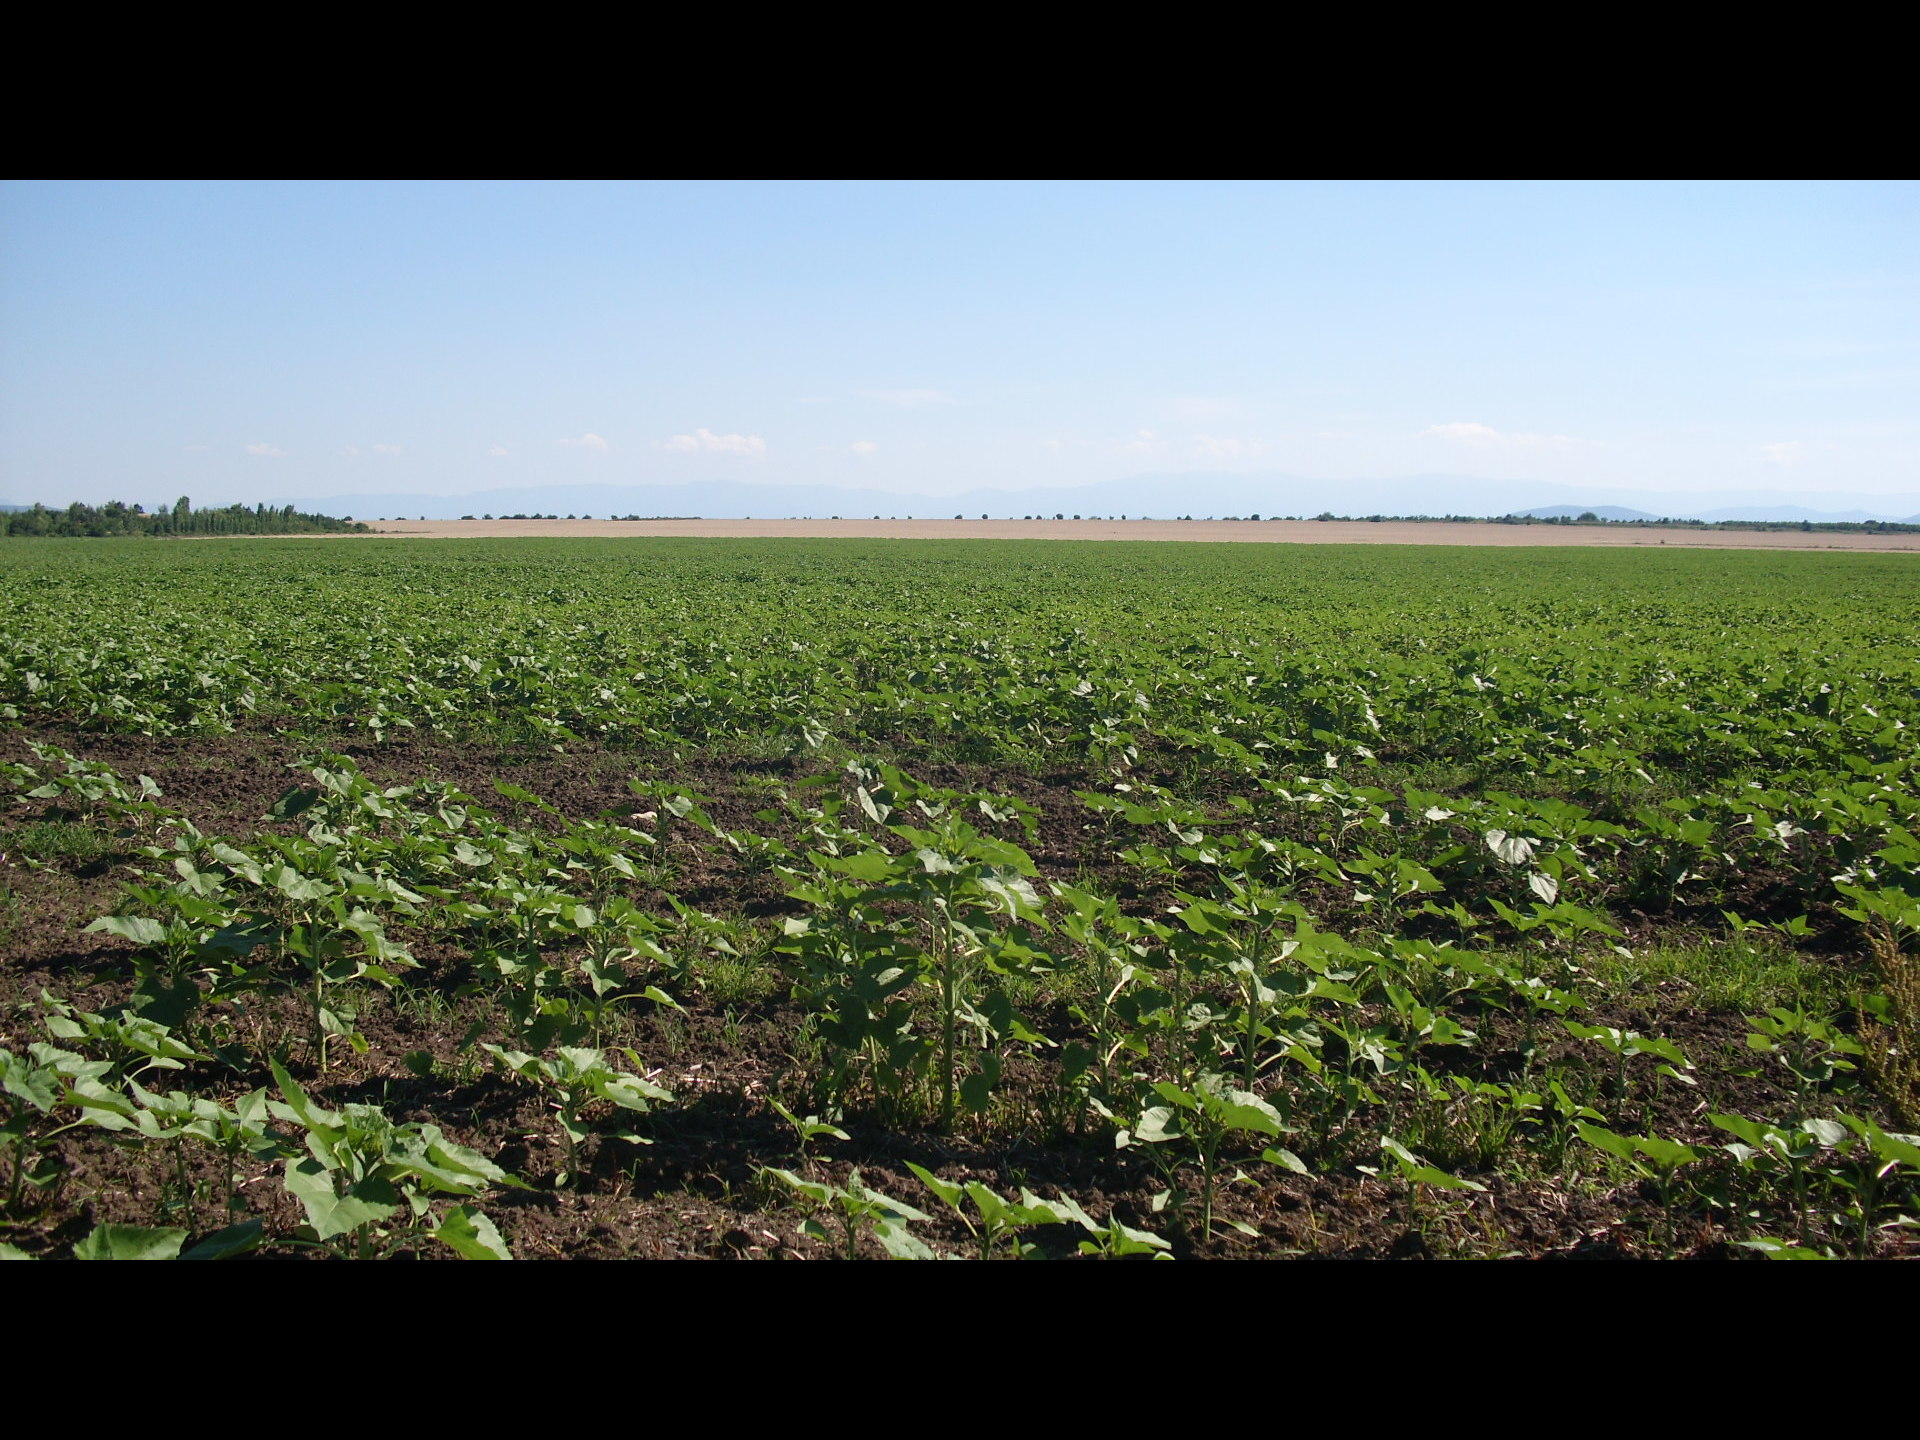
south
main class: Cropland
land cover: Sunflower
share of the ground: 50 - 75 %
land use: Agriculture (excluding fallow land and kitchen gardens)
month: June
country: BG
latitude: 43.5516
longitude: 23.2486
